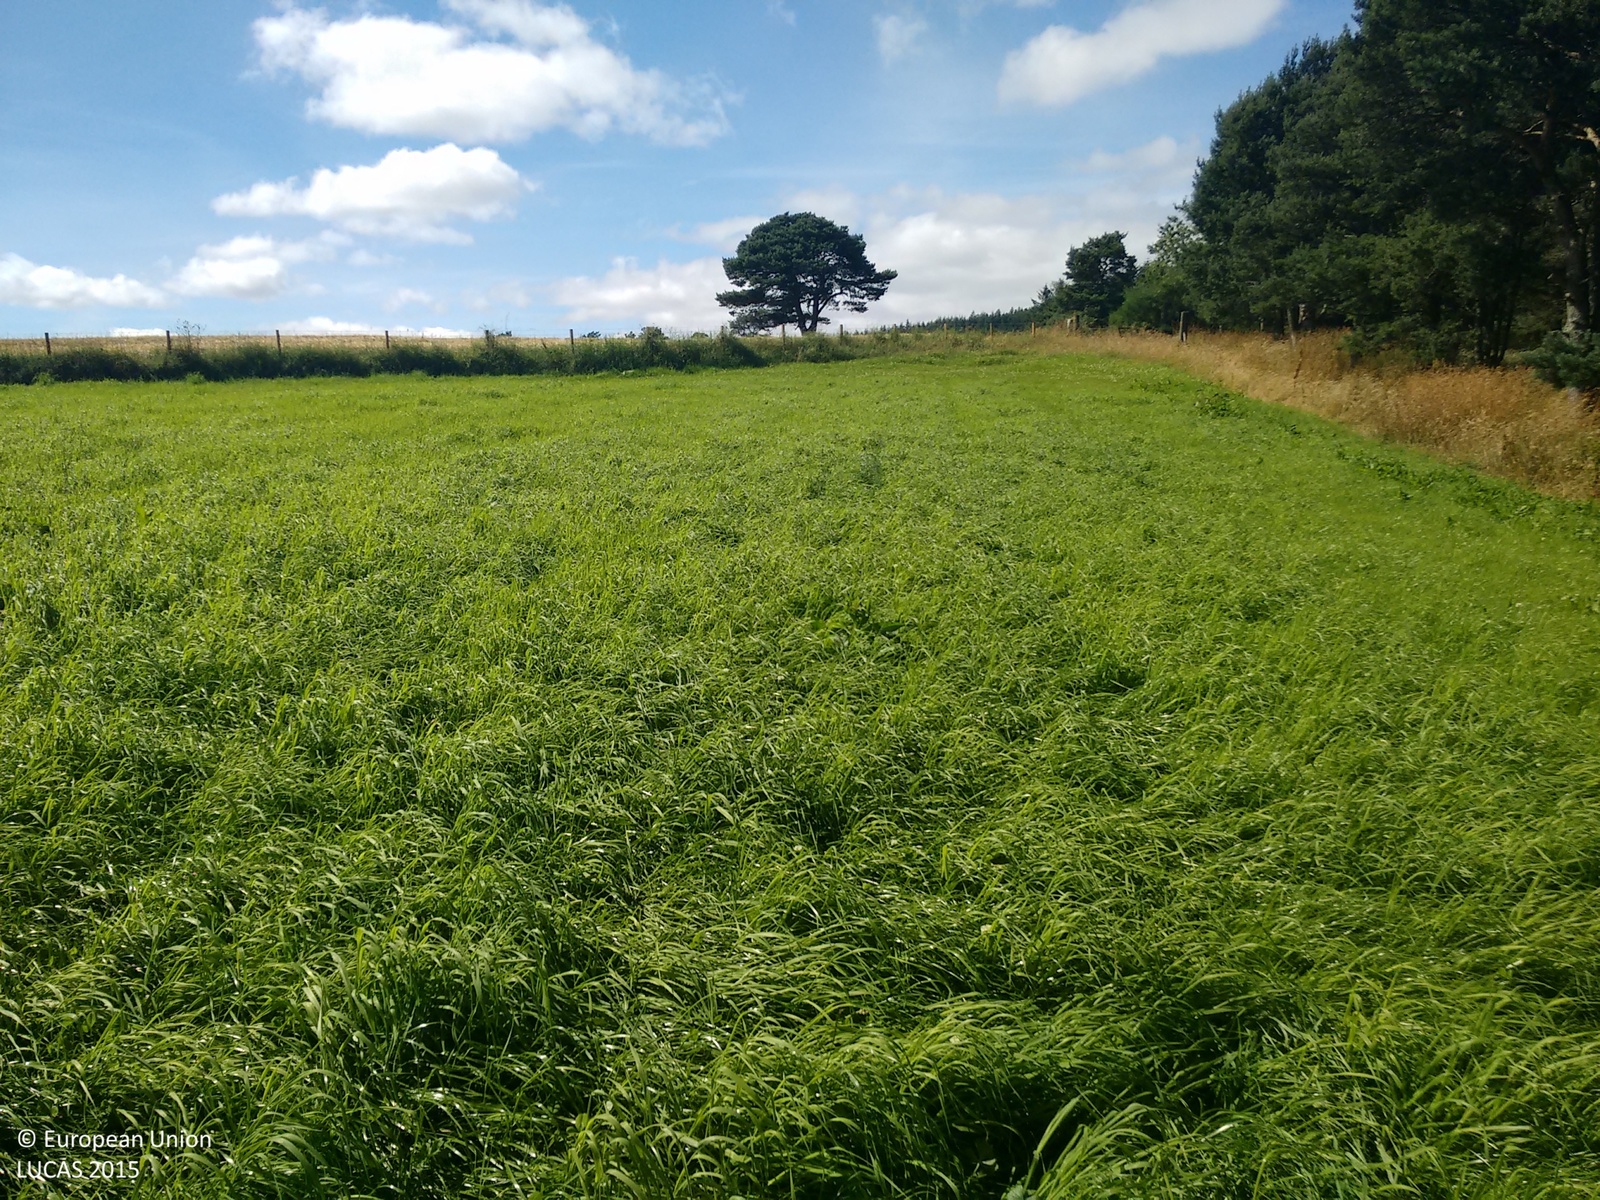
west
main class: Grassland
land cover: Grassland without tree/shrub cover
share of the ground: > 75 %
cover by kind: herbaceous plants 100 %
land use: Agriculture (excluding fallow land and kitchen gardens)
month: August
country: GB
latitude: 57.5470
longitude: -3.0104
